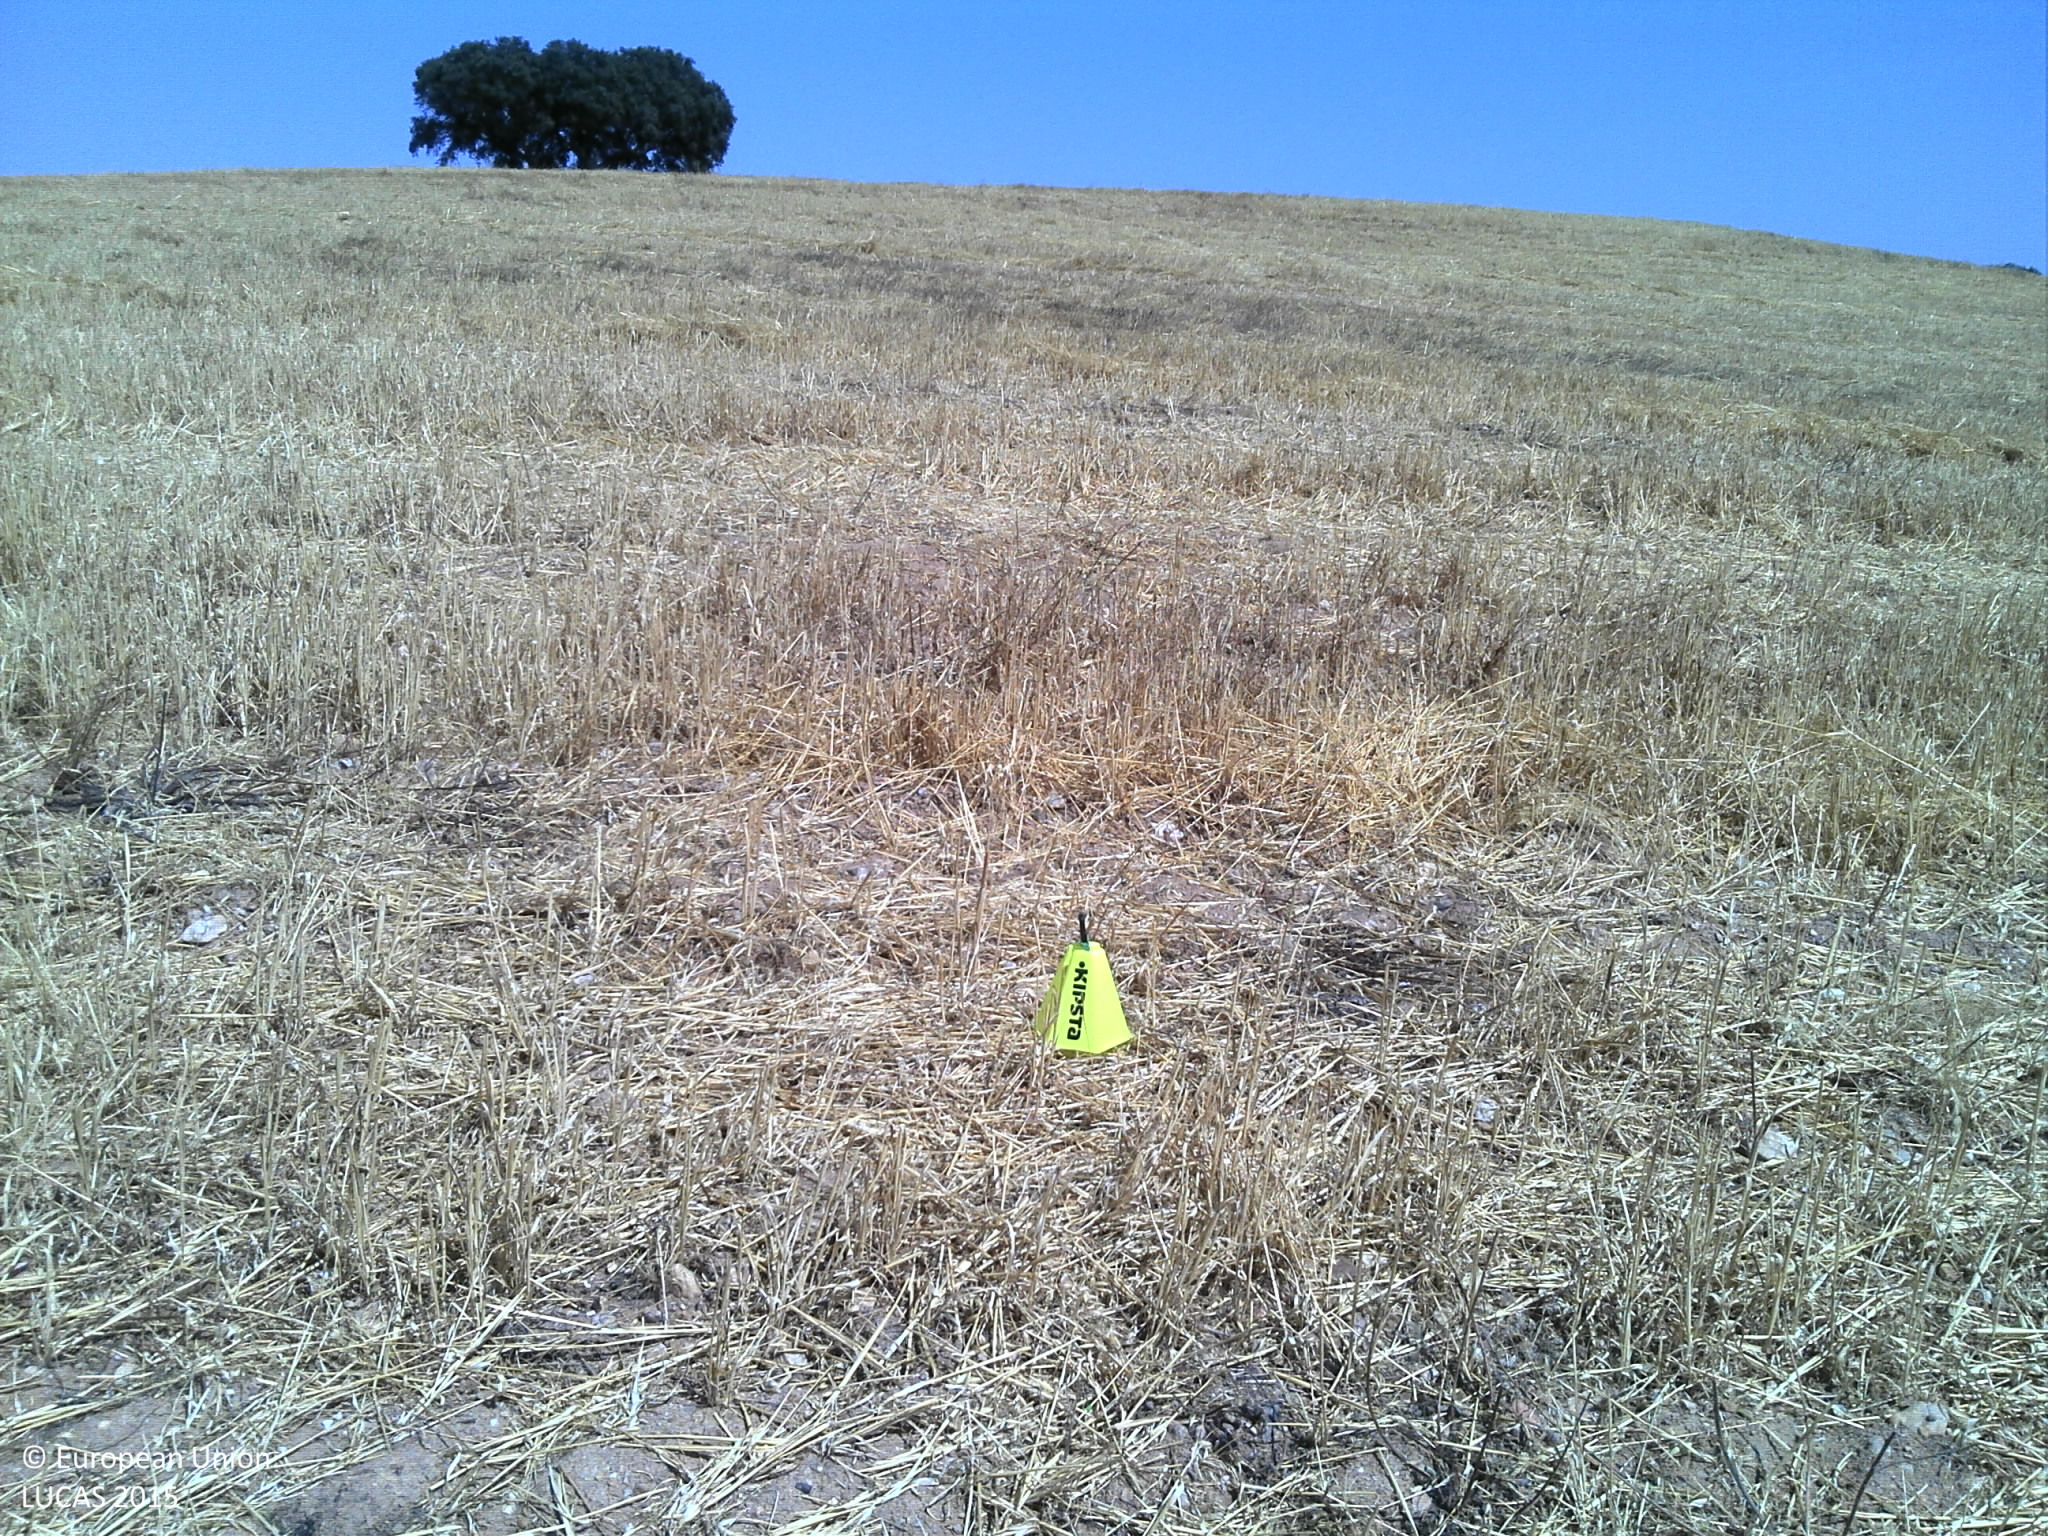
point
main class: Cropland
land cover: Oats
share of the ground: < 10 %
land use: Agriculture (excluding fallow land and kitchen gardens)
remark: Harvested field
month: July
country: PT
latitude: 38.4115
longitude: -7.6557
